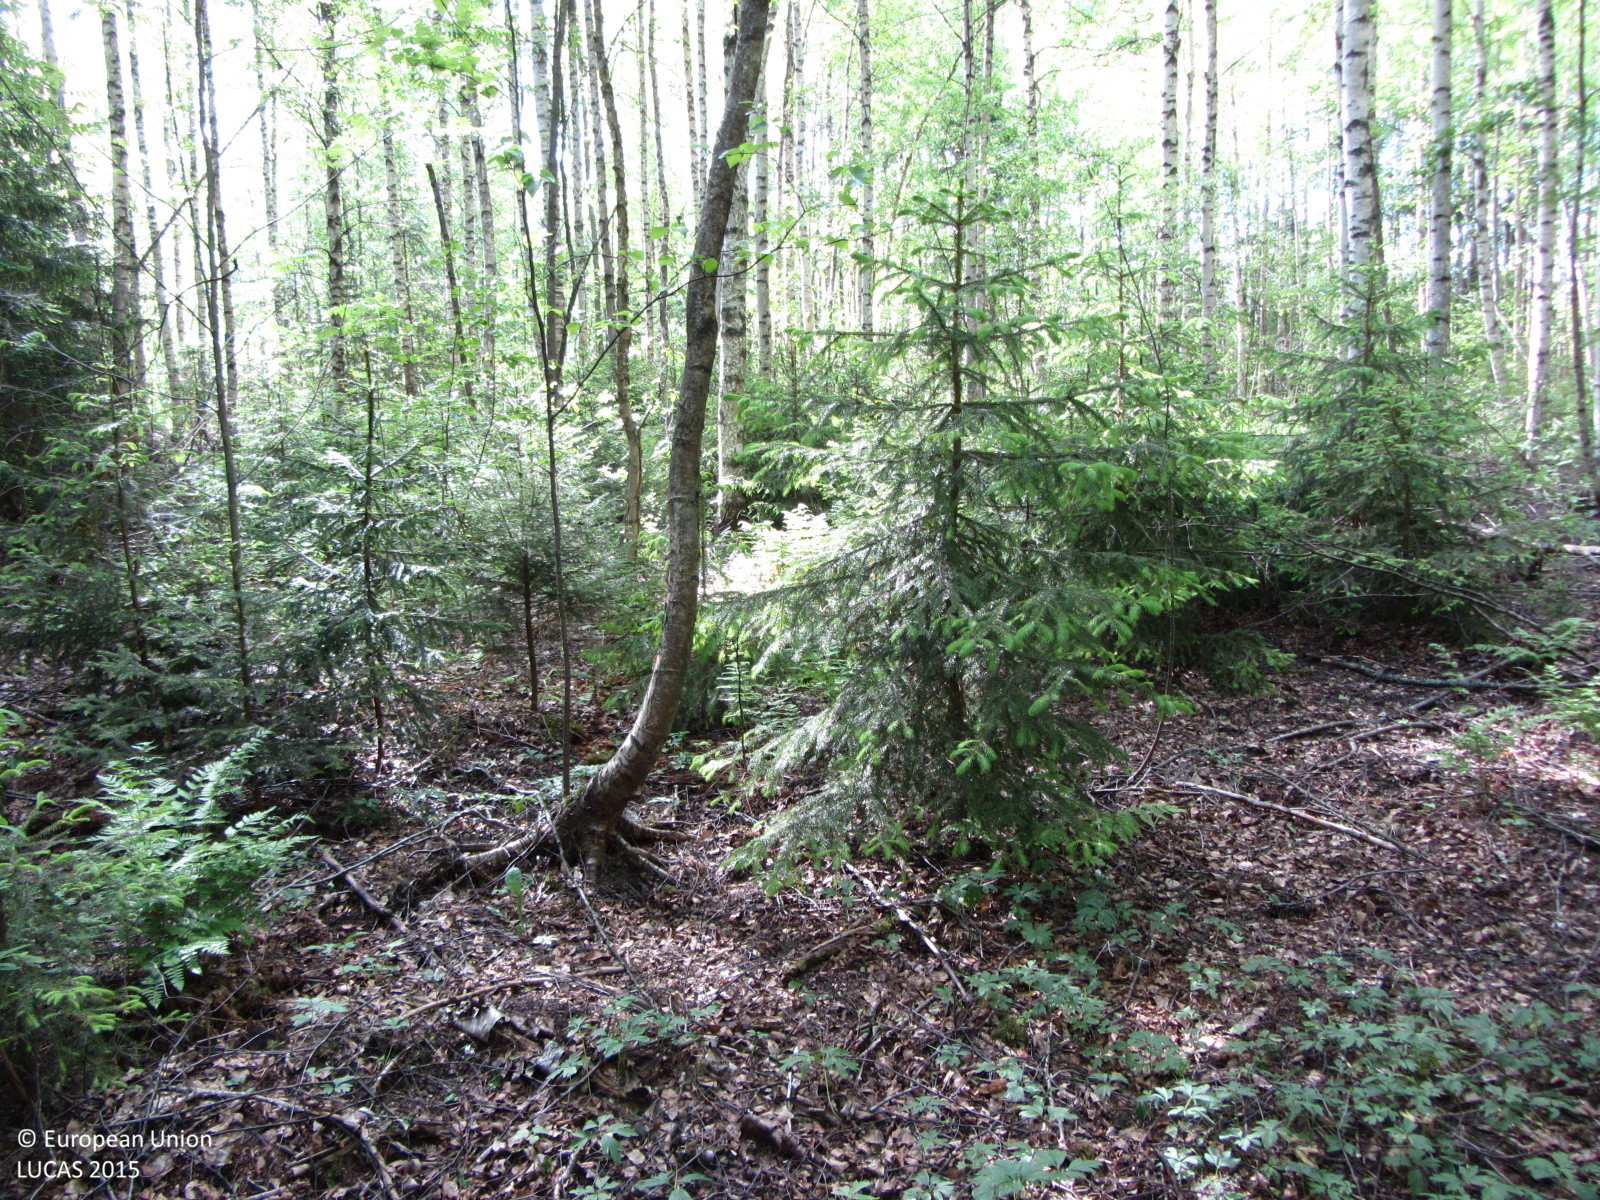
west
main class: Woodland
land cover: Broadleaved woodland
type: boreal forest
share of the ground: > 75 %
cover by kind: broadleaved forest trees 85 %, coniferous forest trees 10 %, herbaceous plants 5 %
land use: Forestry
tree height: > 5 m
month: June
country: FI
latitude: 60.2937
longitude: 24.2680
